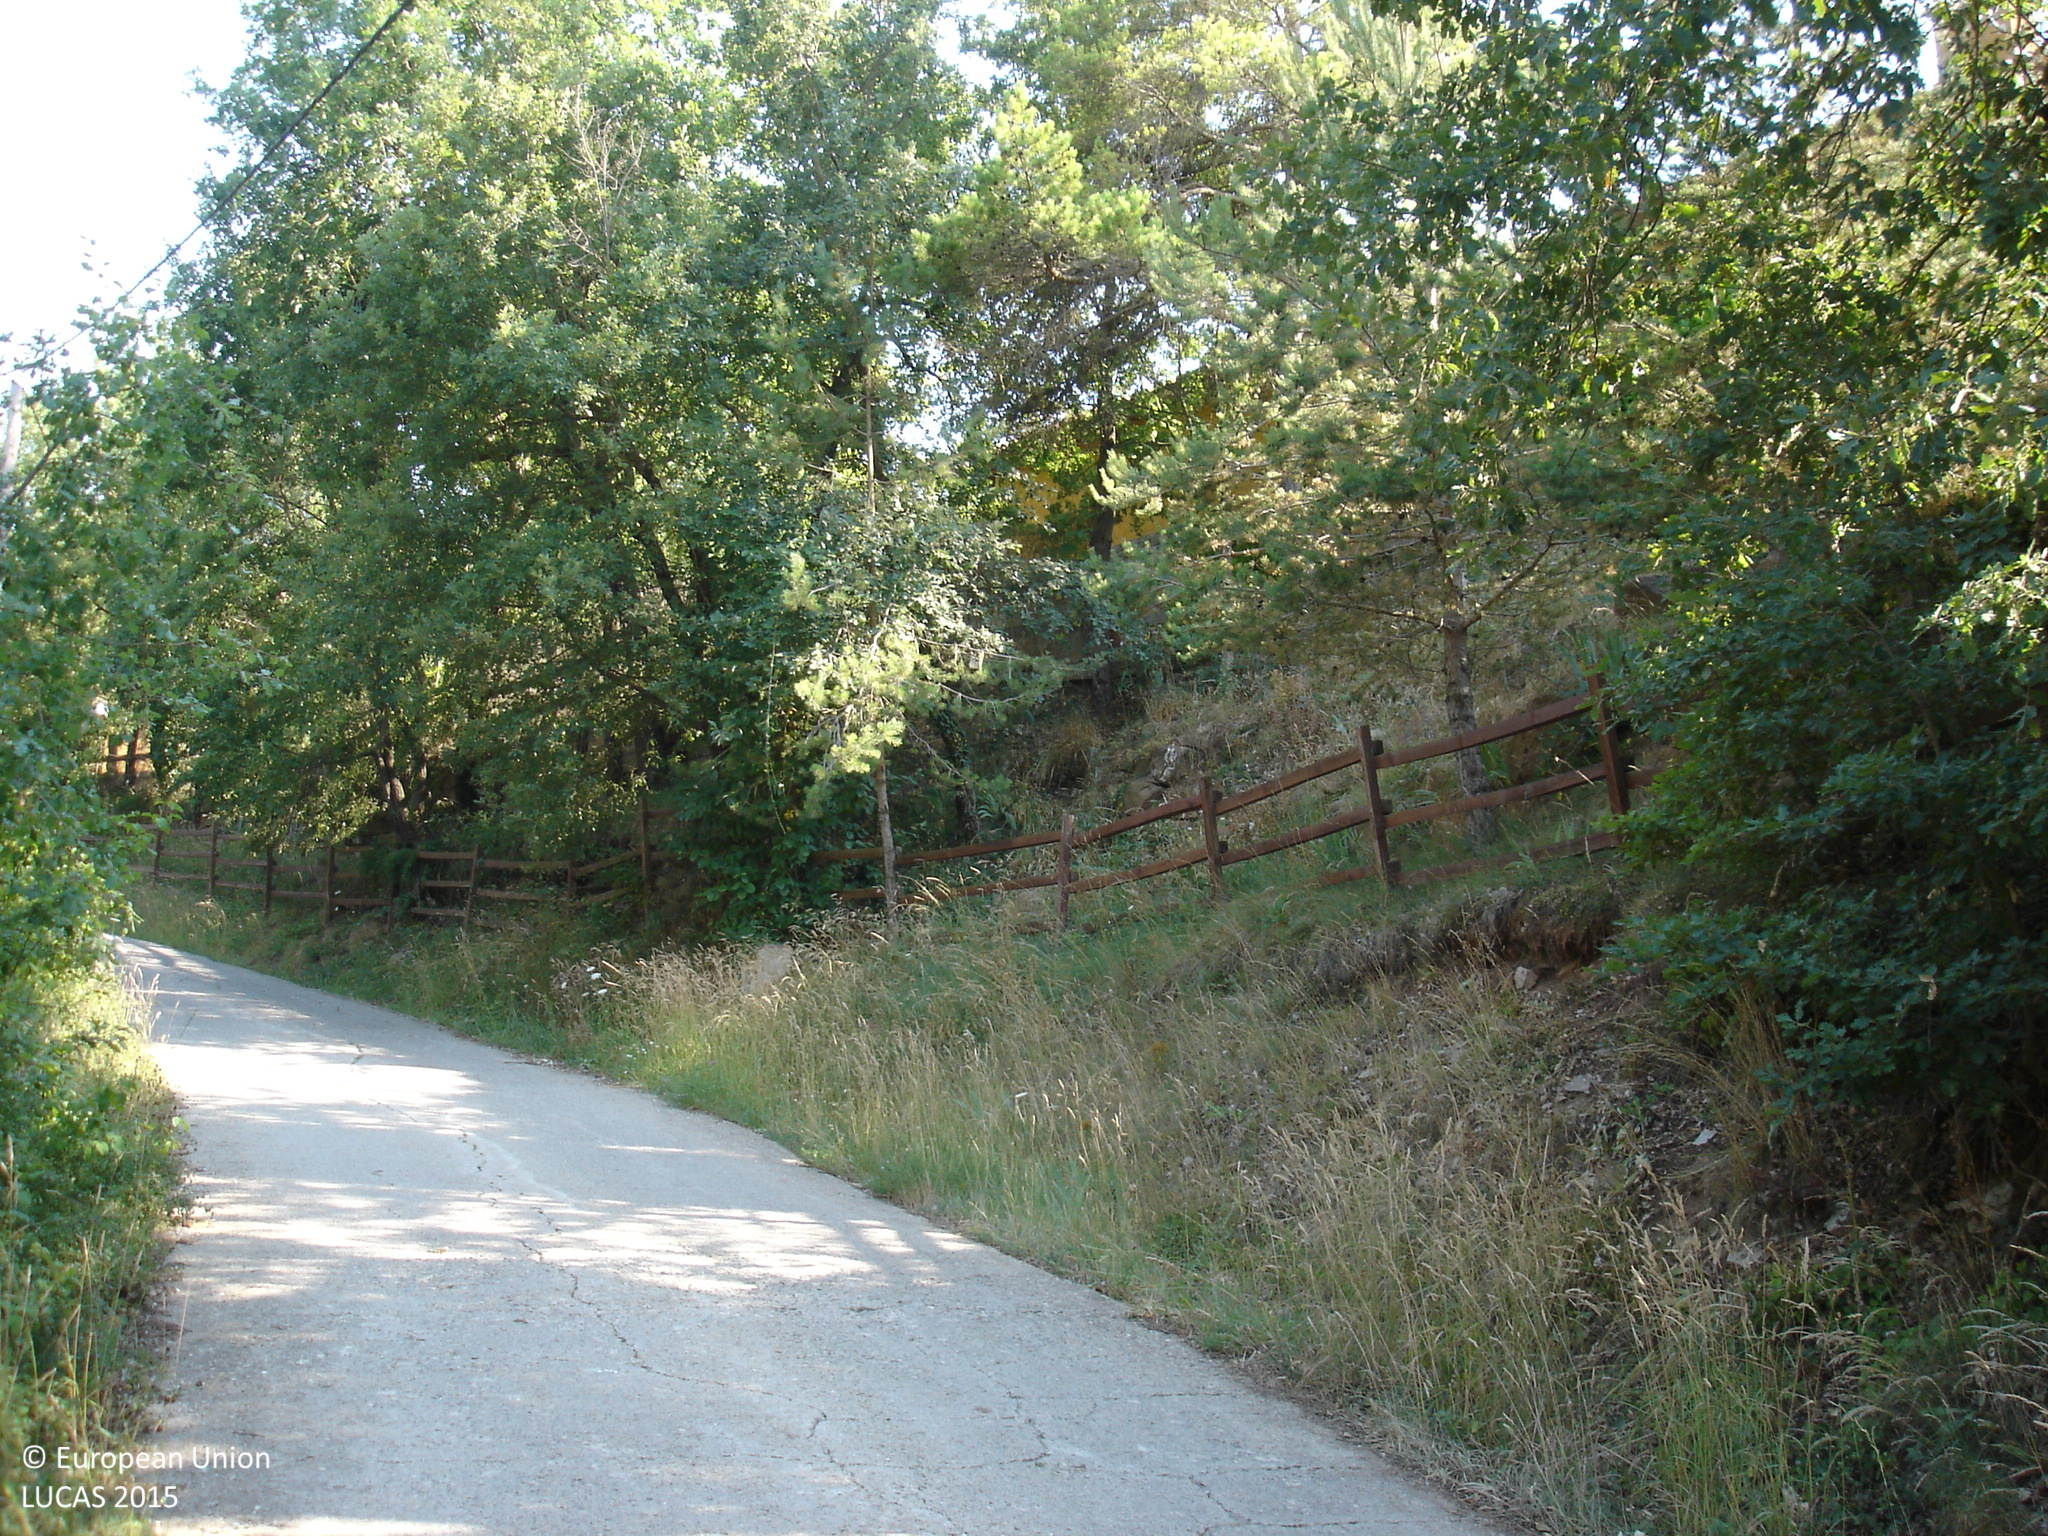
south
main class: Woodland
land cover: Other mixed woodland
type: thermophilous deciduous forest
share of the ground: 25 - 50 %
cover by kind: herbaceous plants 50 %, broadleaved forest trees 30 %, coniferous forest trees 10 %, shrubs 5 %
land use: Forestry
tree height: > 5 m
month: July
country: ES
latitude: 41.8610
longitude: 2.1728
